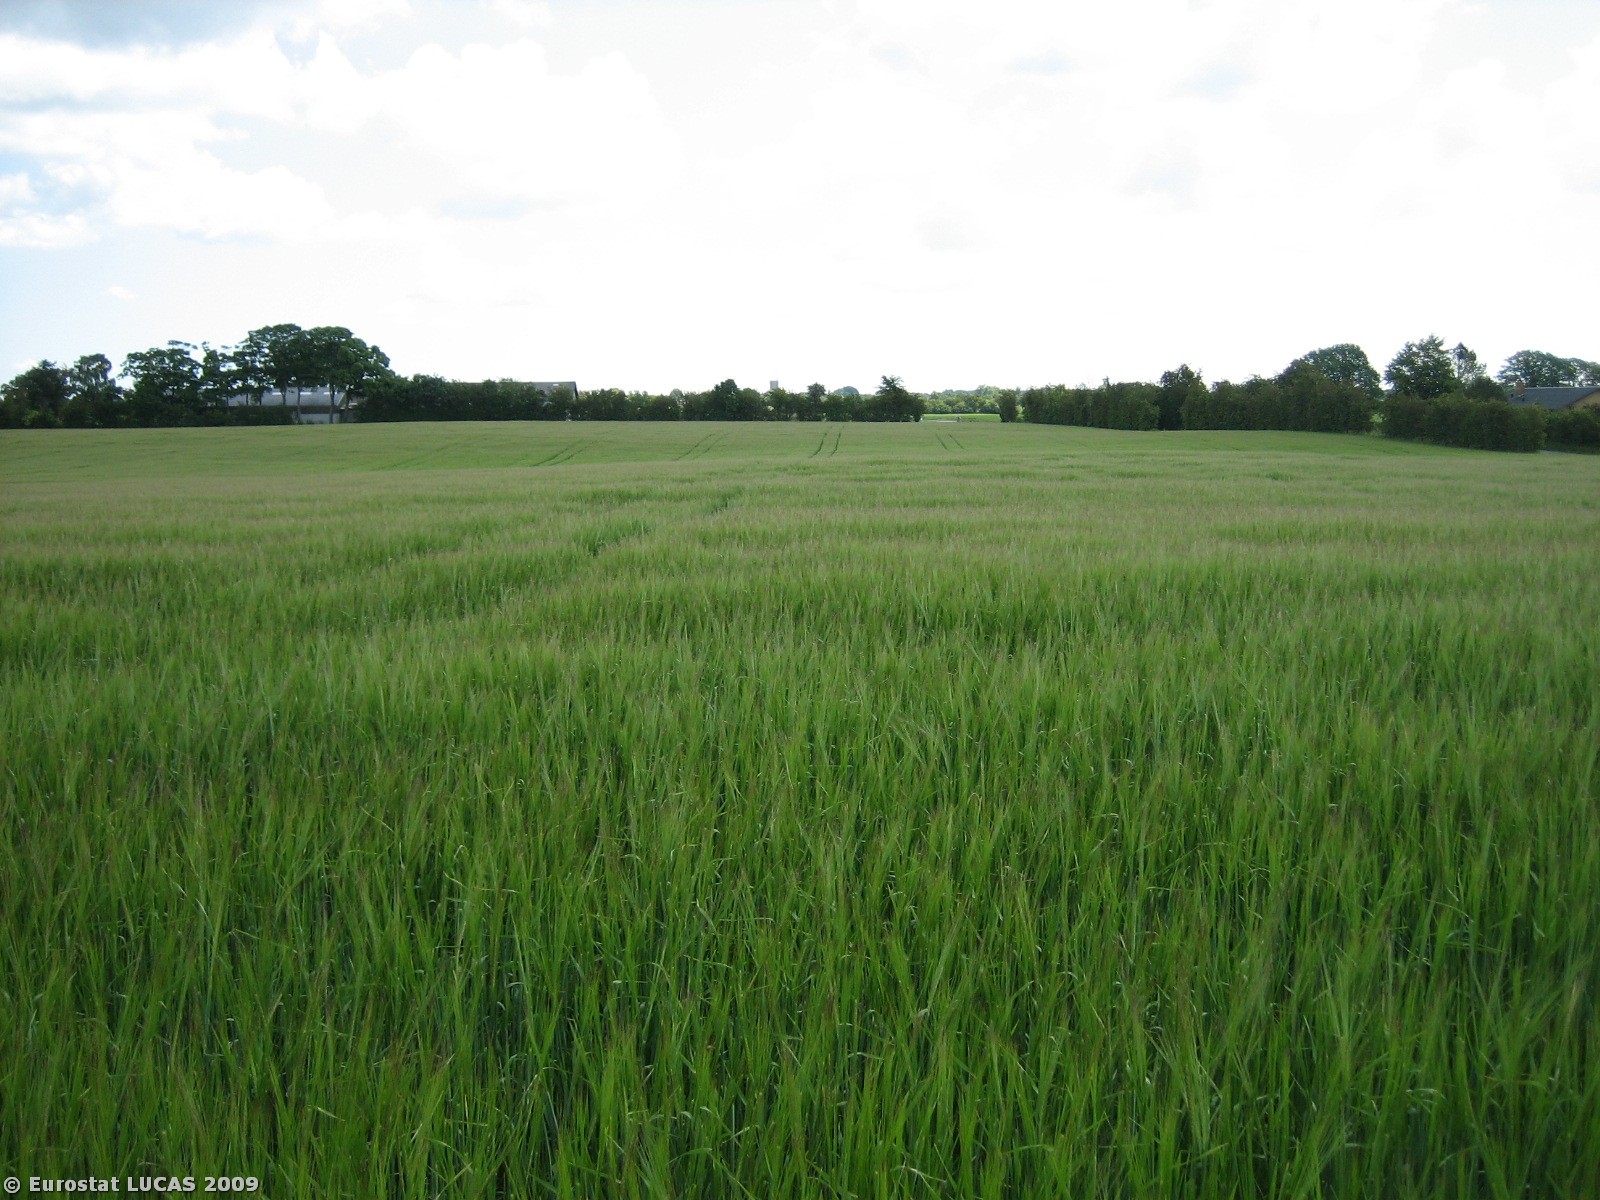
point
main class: Cropland
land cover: Barley
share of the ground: > 75 %
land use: Agriculture (excluding fallow land and kitchen gardens)
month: June
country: DK
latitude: 55.5566
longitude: 9.2873
